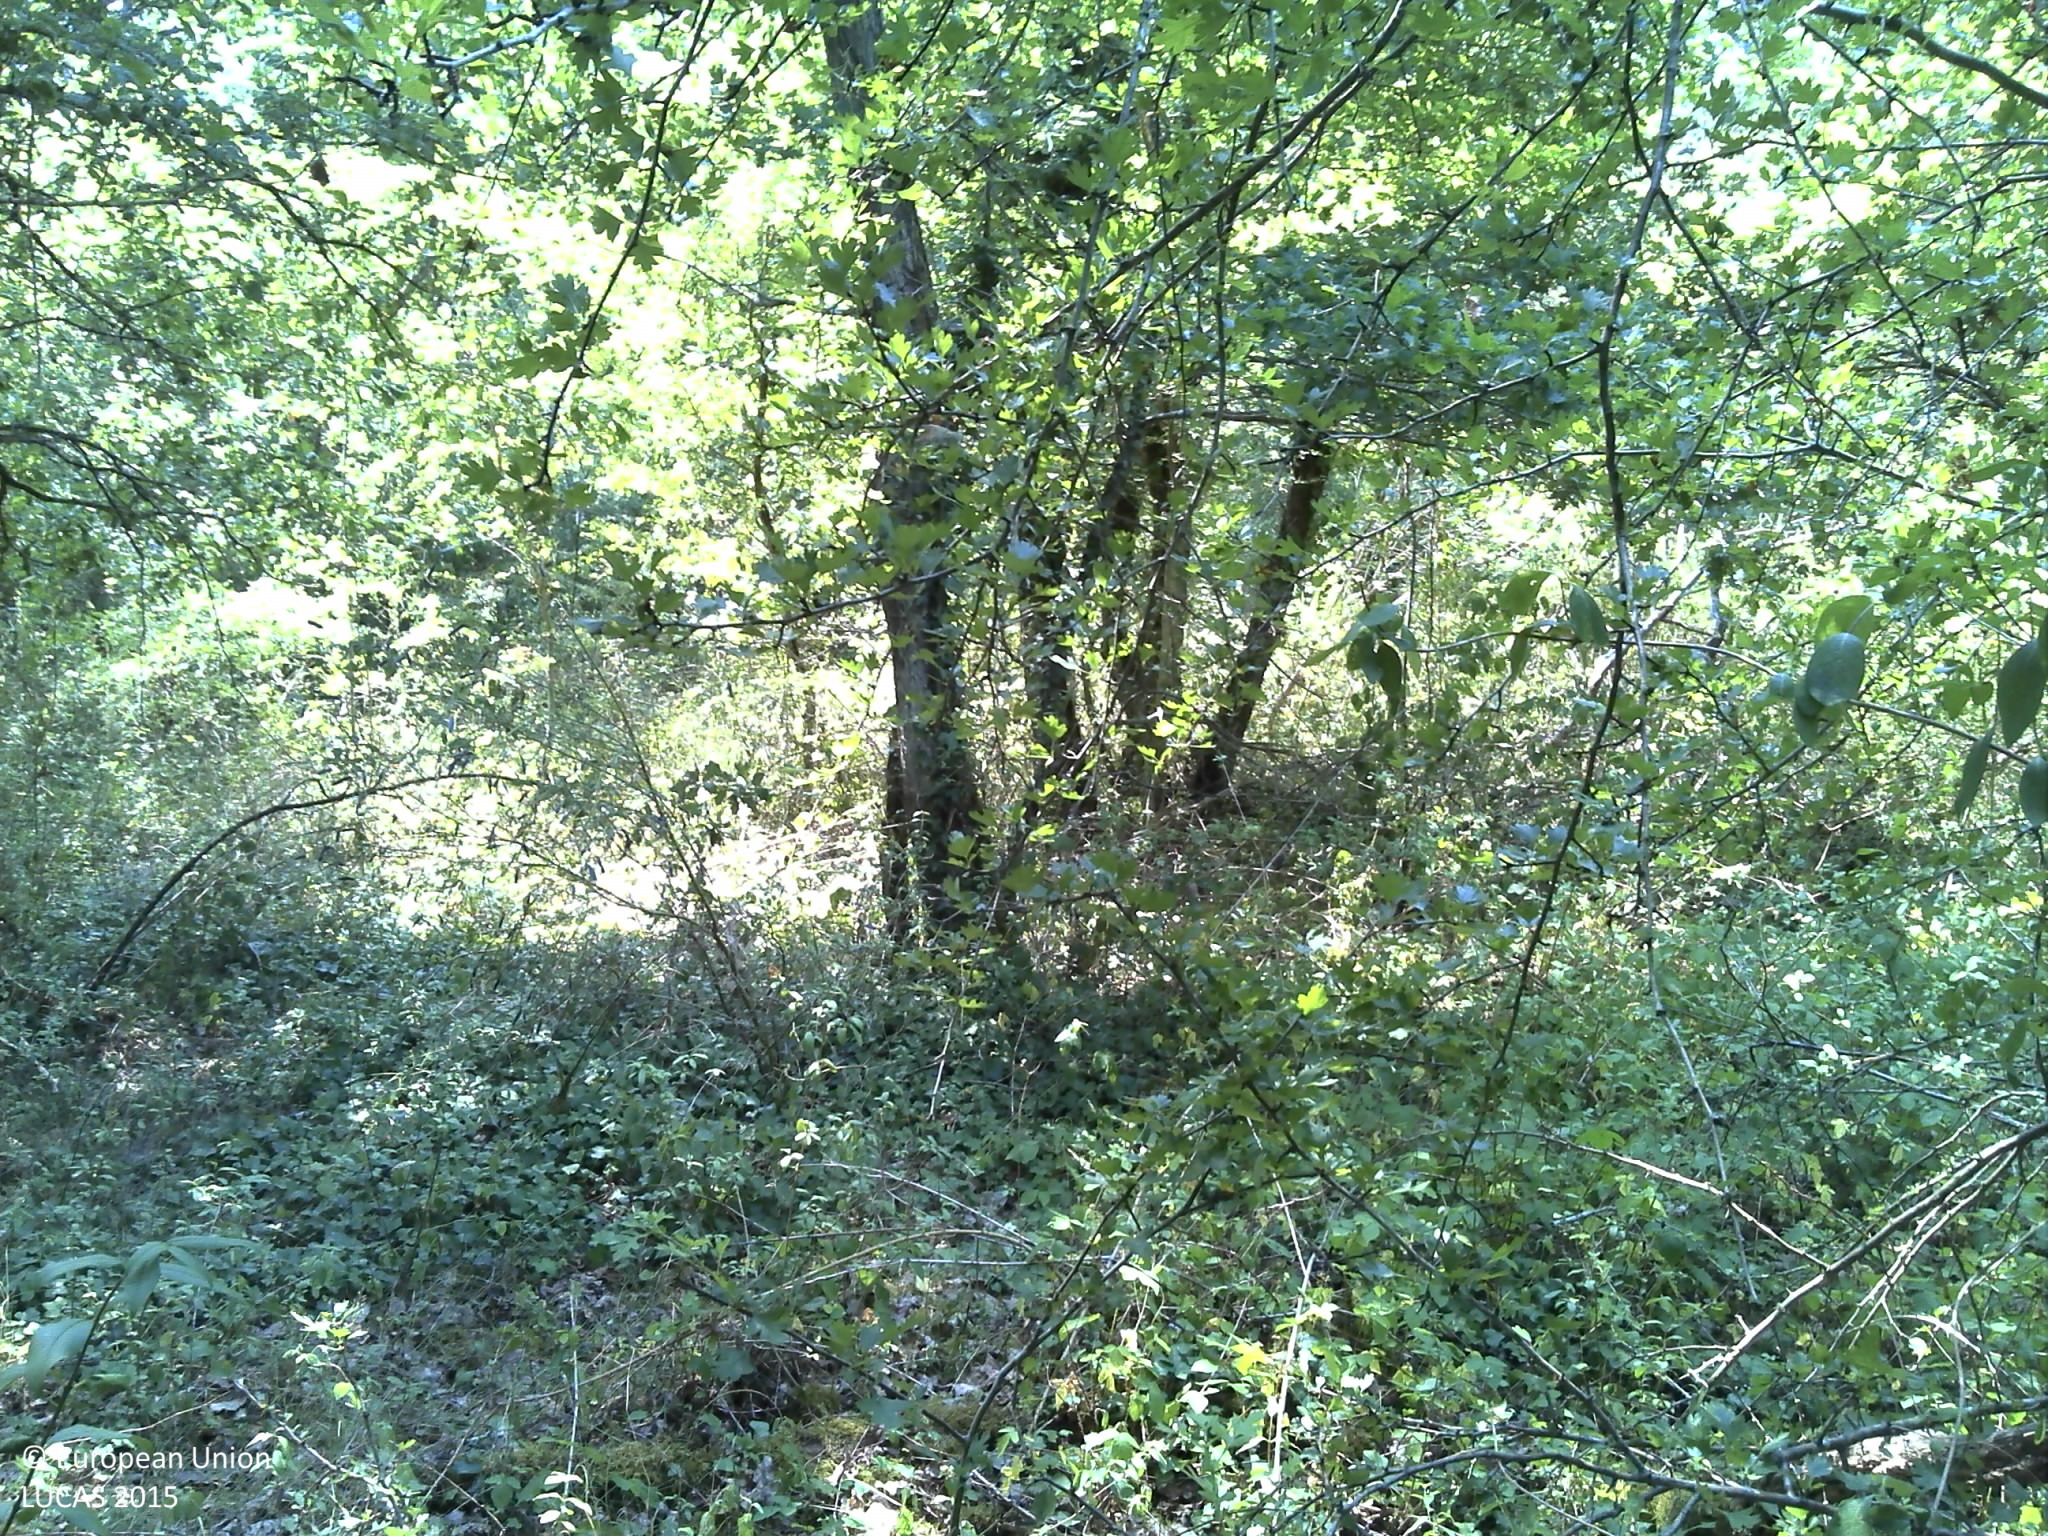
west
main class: Woodland
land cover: Broadleaved woodland
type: acidophilous oak and oak-birch forest
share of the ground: 50 - 75 %
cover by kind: broadleaved forest trees 90 %
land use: Forestry
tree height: > 5 m
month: July
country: FR
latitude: 48.4153
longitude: 2.4364
